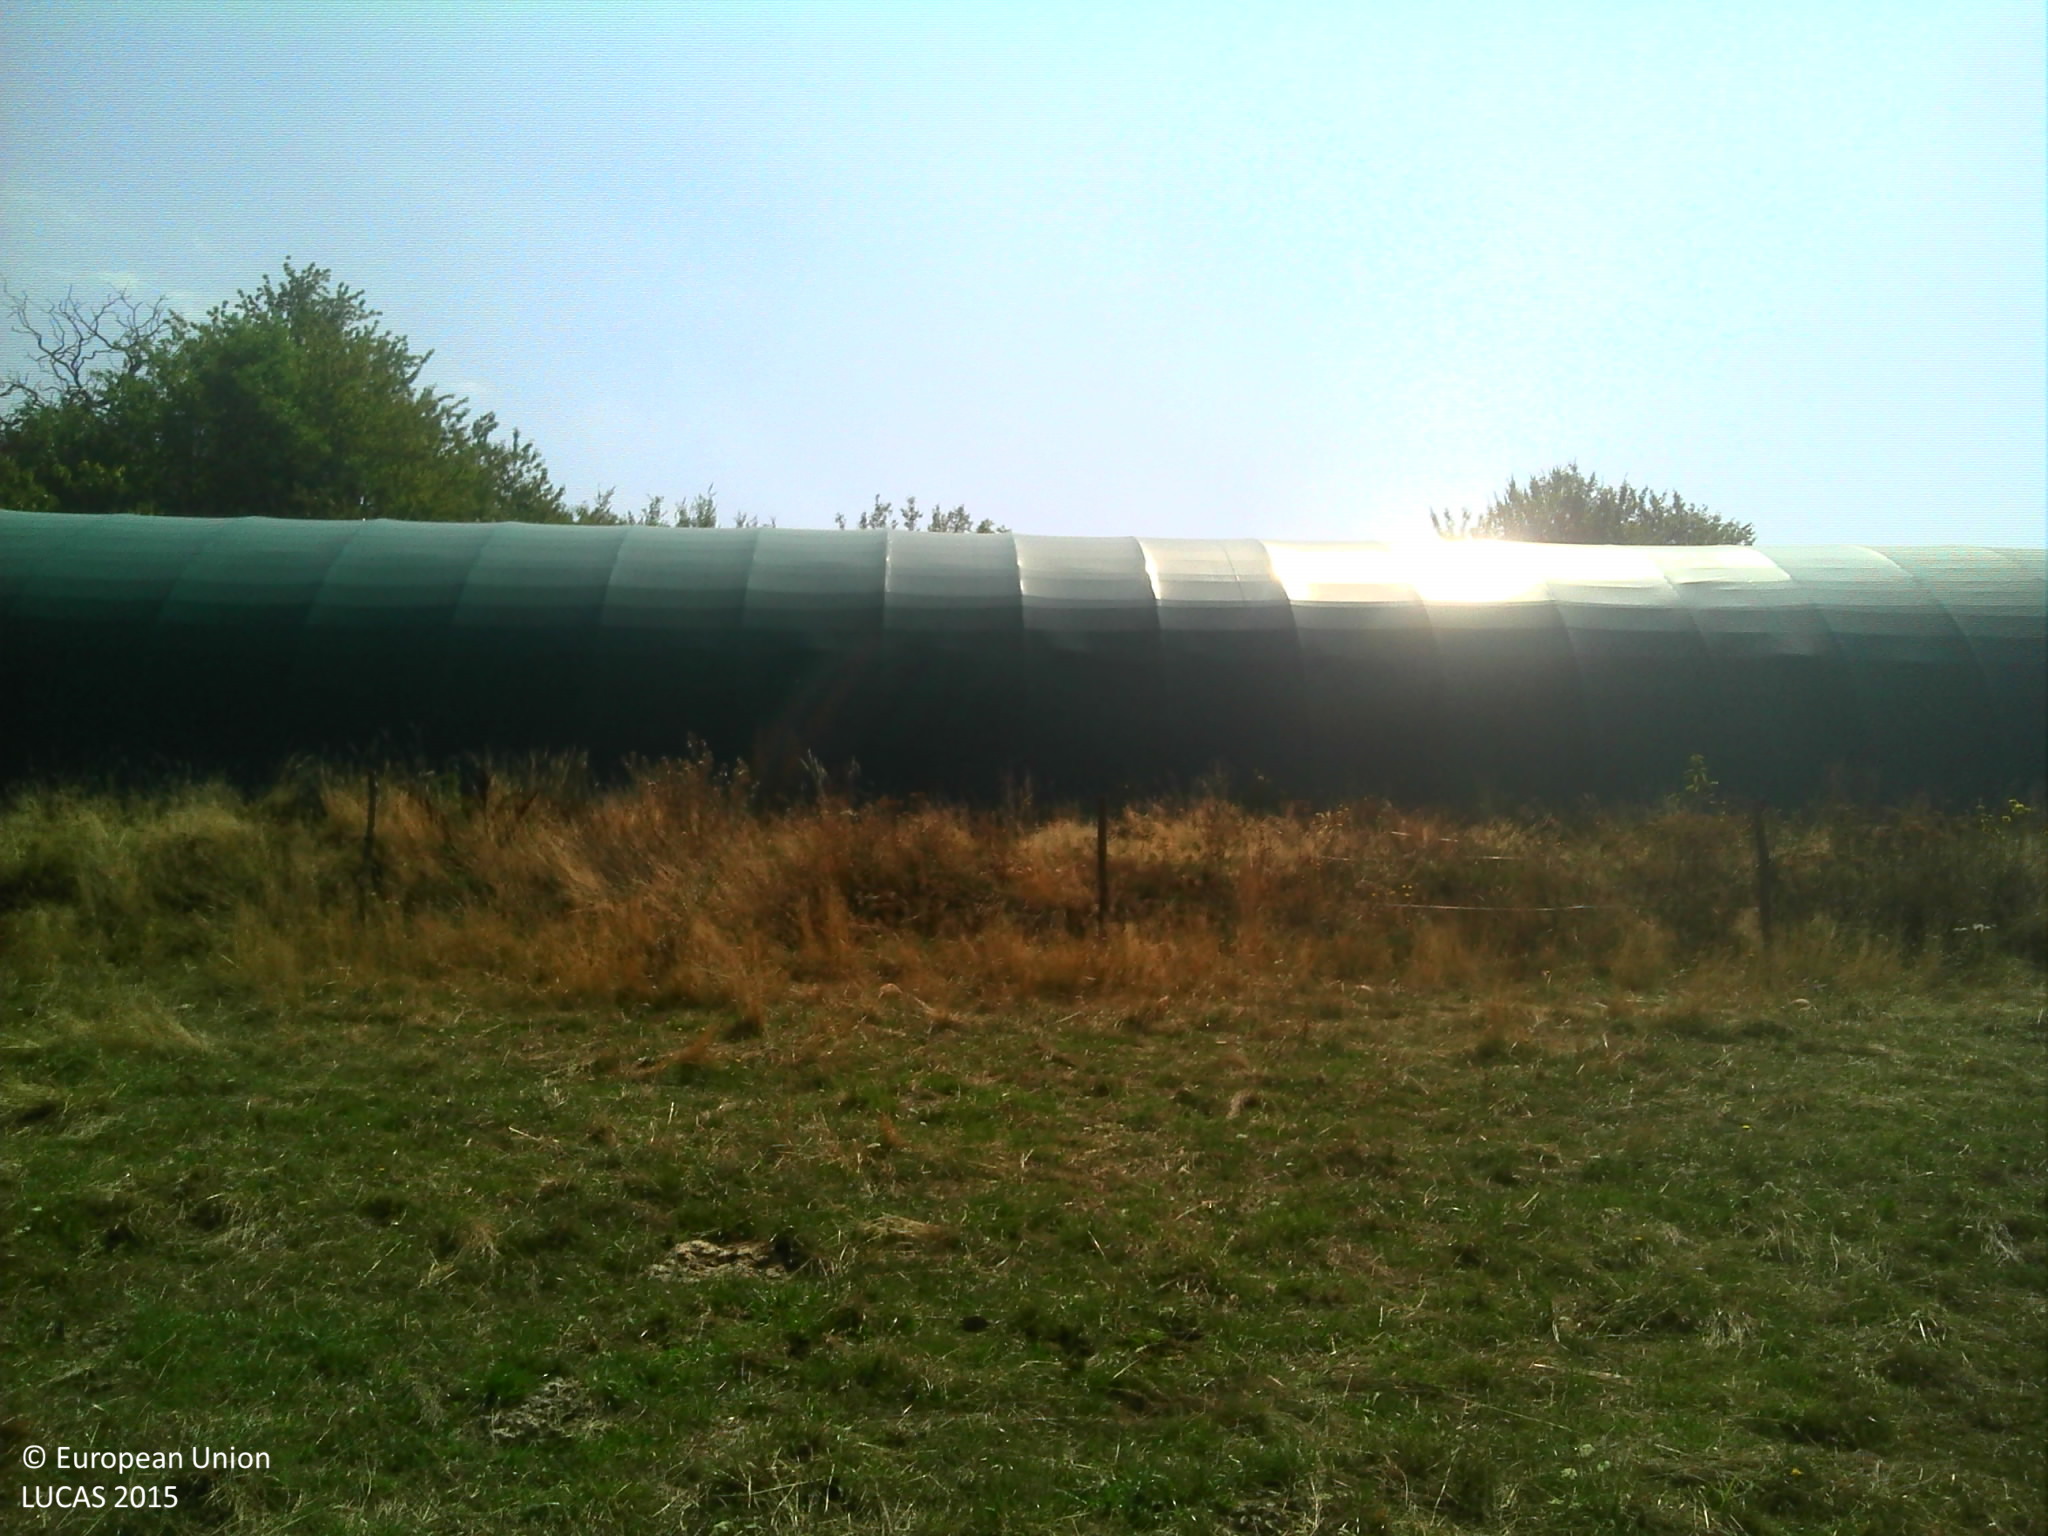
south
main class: Grassland
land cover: Grassland without tree/shrub cover
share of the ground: > 75 %
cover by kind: herbaceous plants 95 %, shrubs 5 %
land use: Agriculture (excluding fallow land and kitchen gardens)
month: September
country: FR
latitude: 45.1946
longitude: 5.1554
